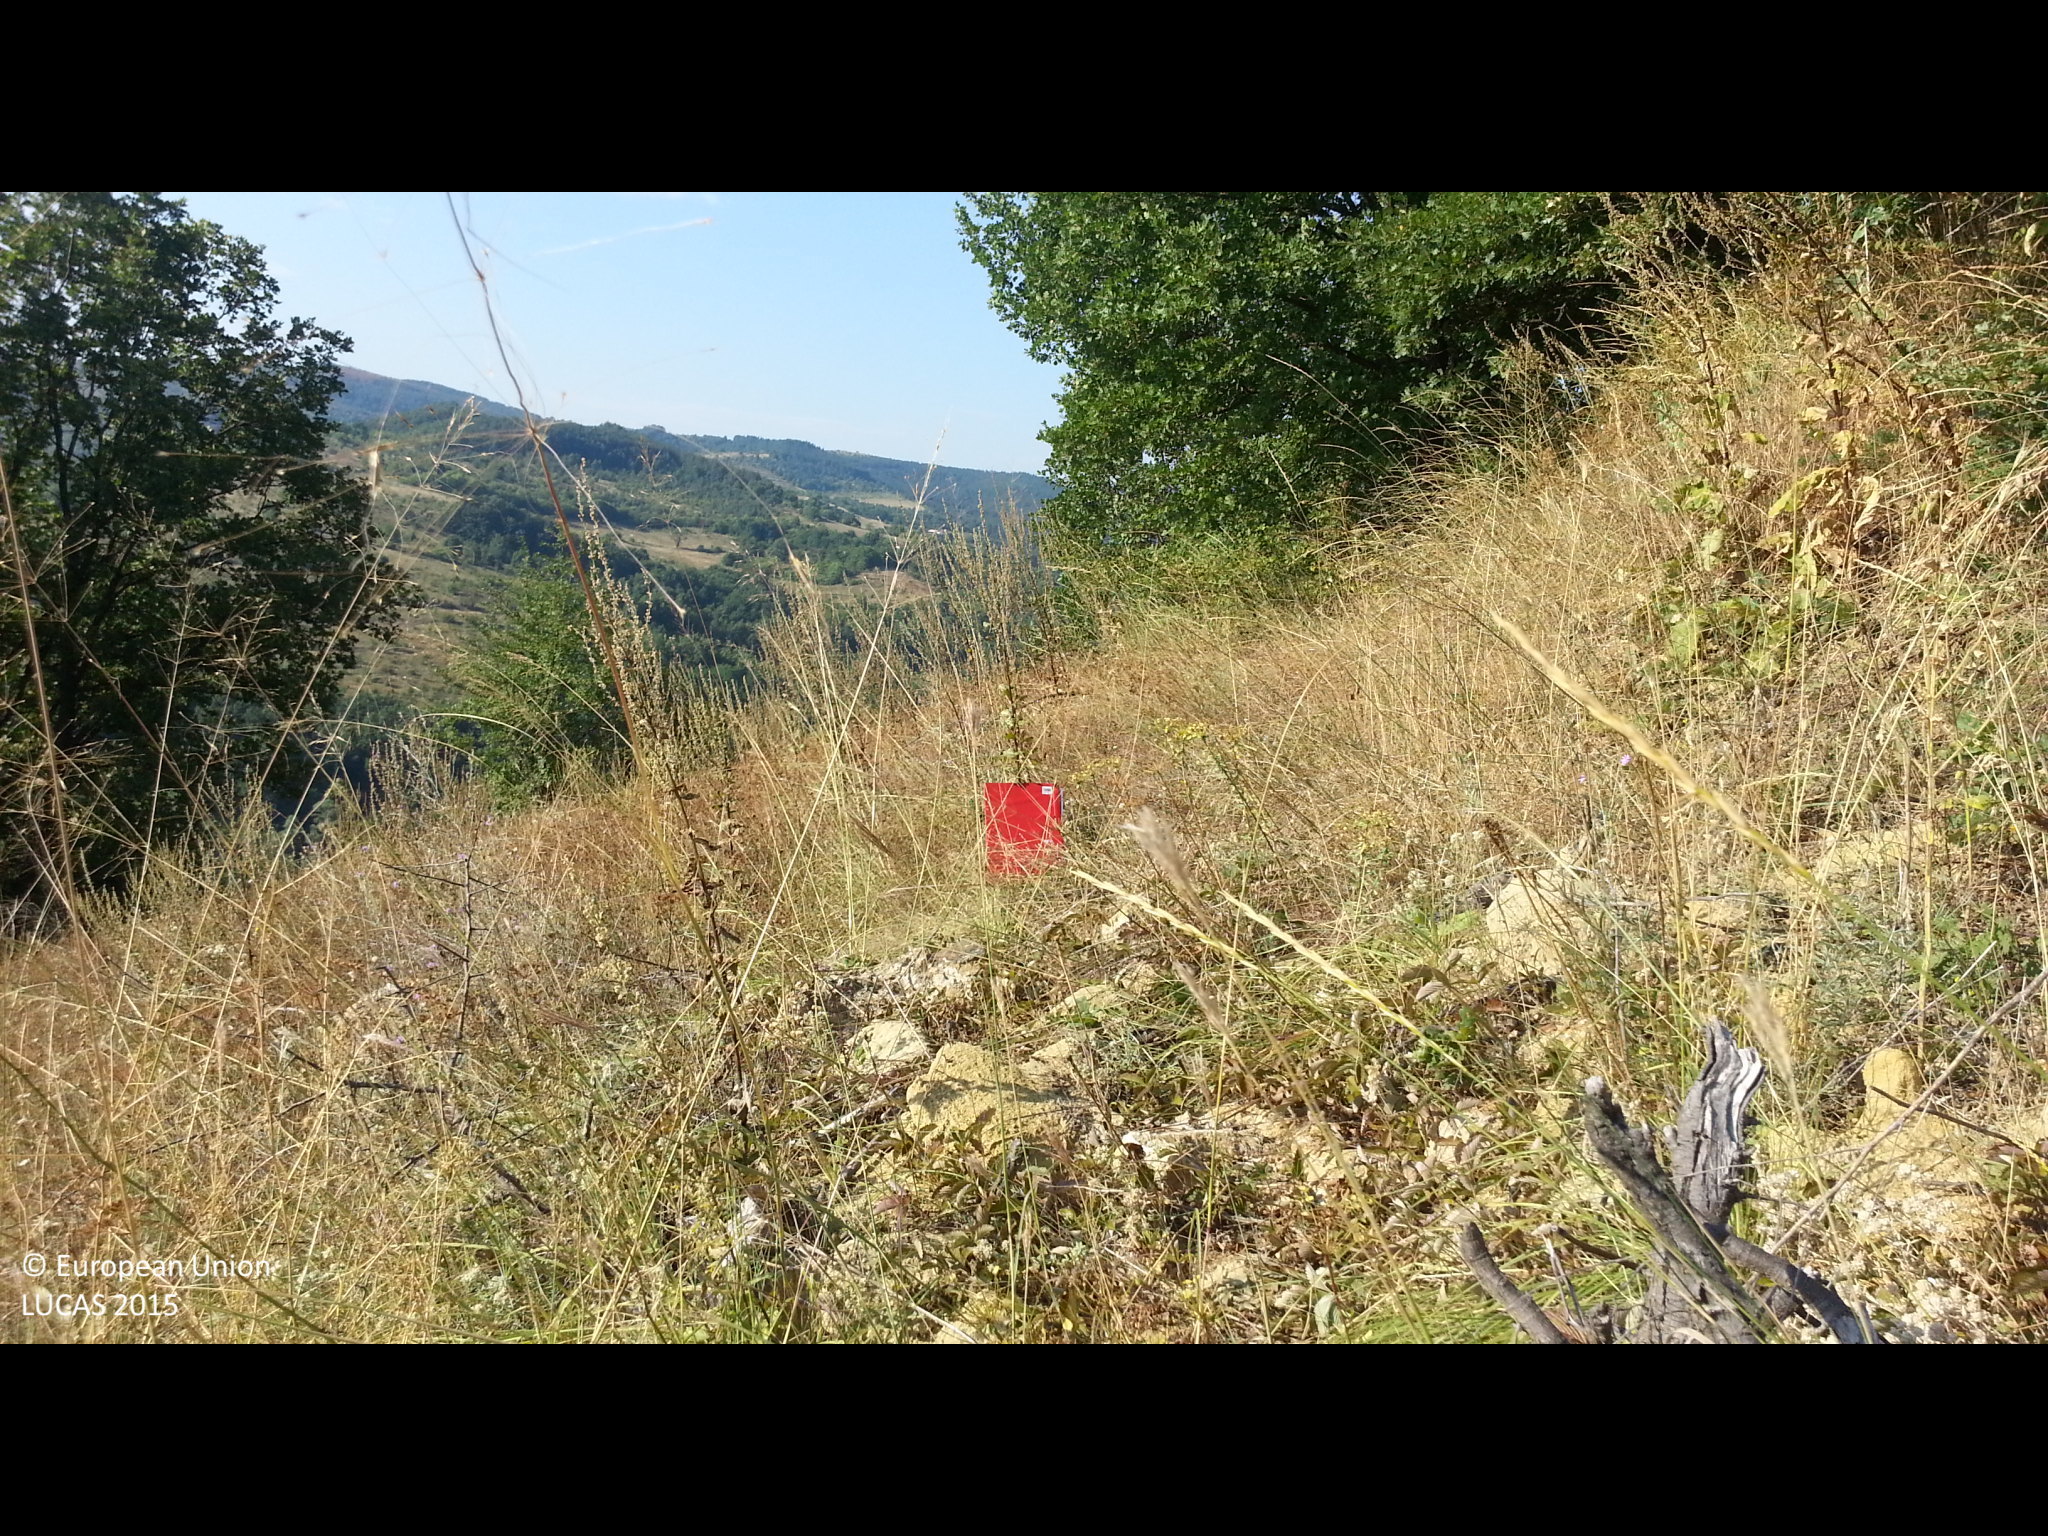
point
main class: Grassland
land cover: Grassland with sparse tree/shrub cover
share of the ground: > 75 %
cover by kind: herbaceous plants 95 %, coniferous forest trees 5 %
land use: Forestry
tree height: > 5 m
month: August
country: BG
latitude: 42.2151
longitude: 22.8515
